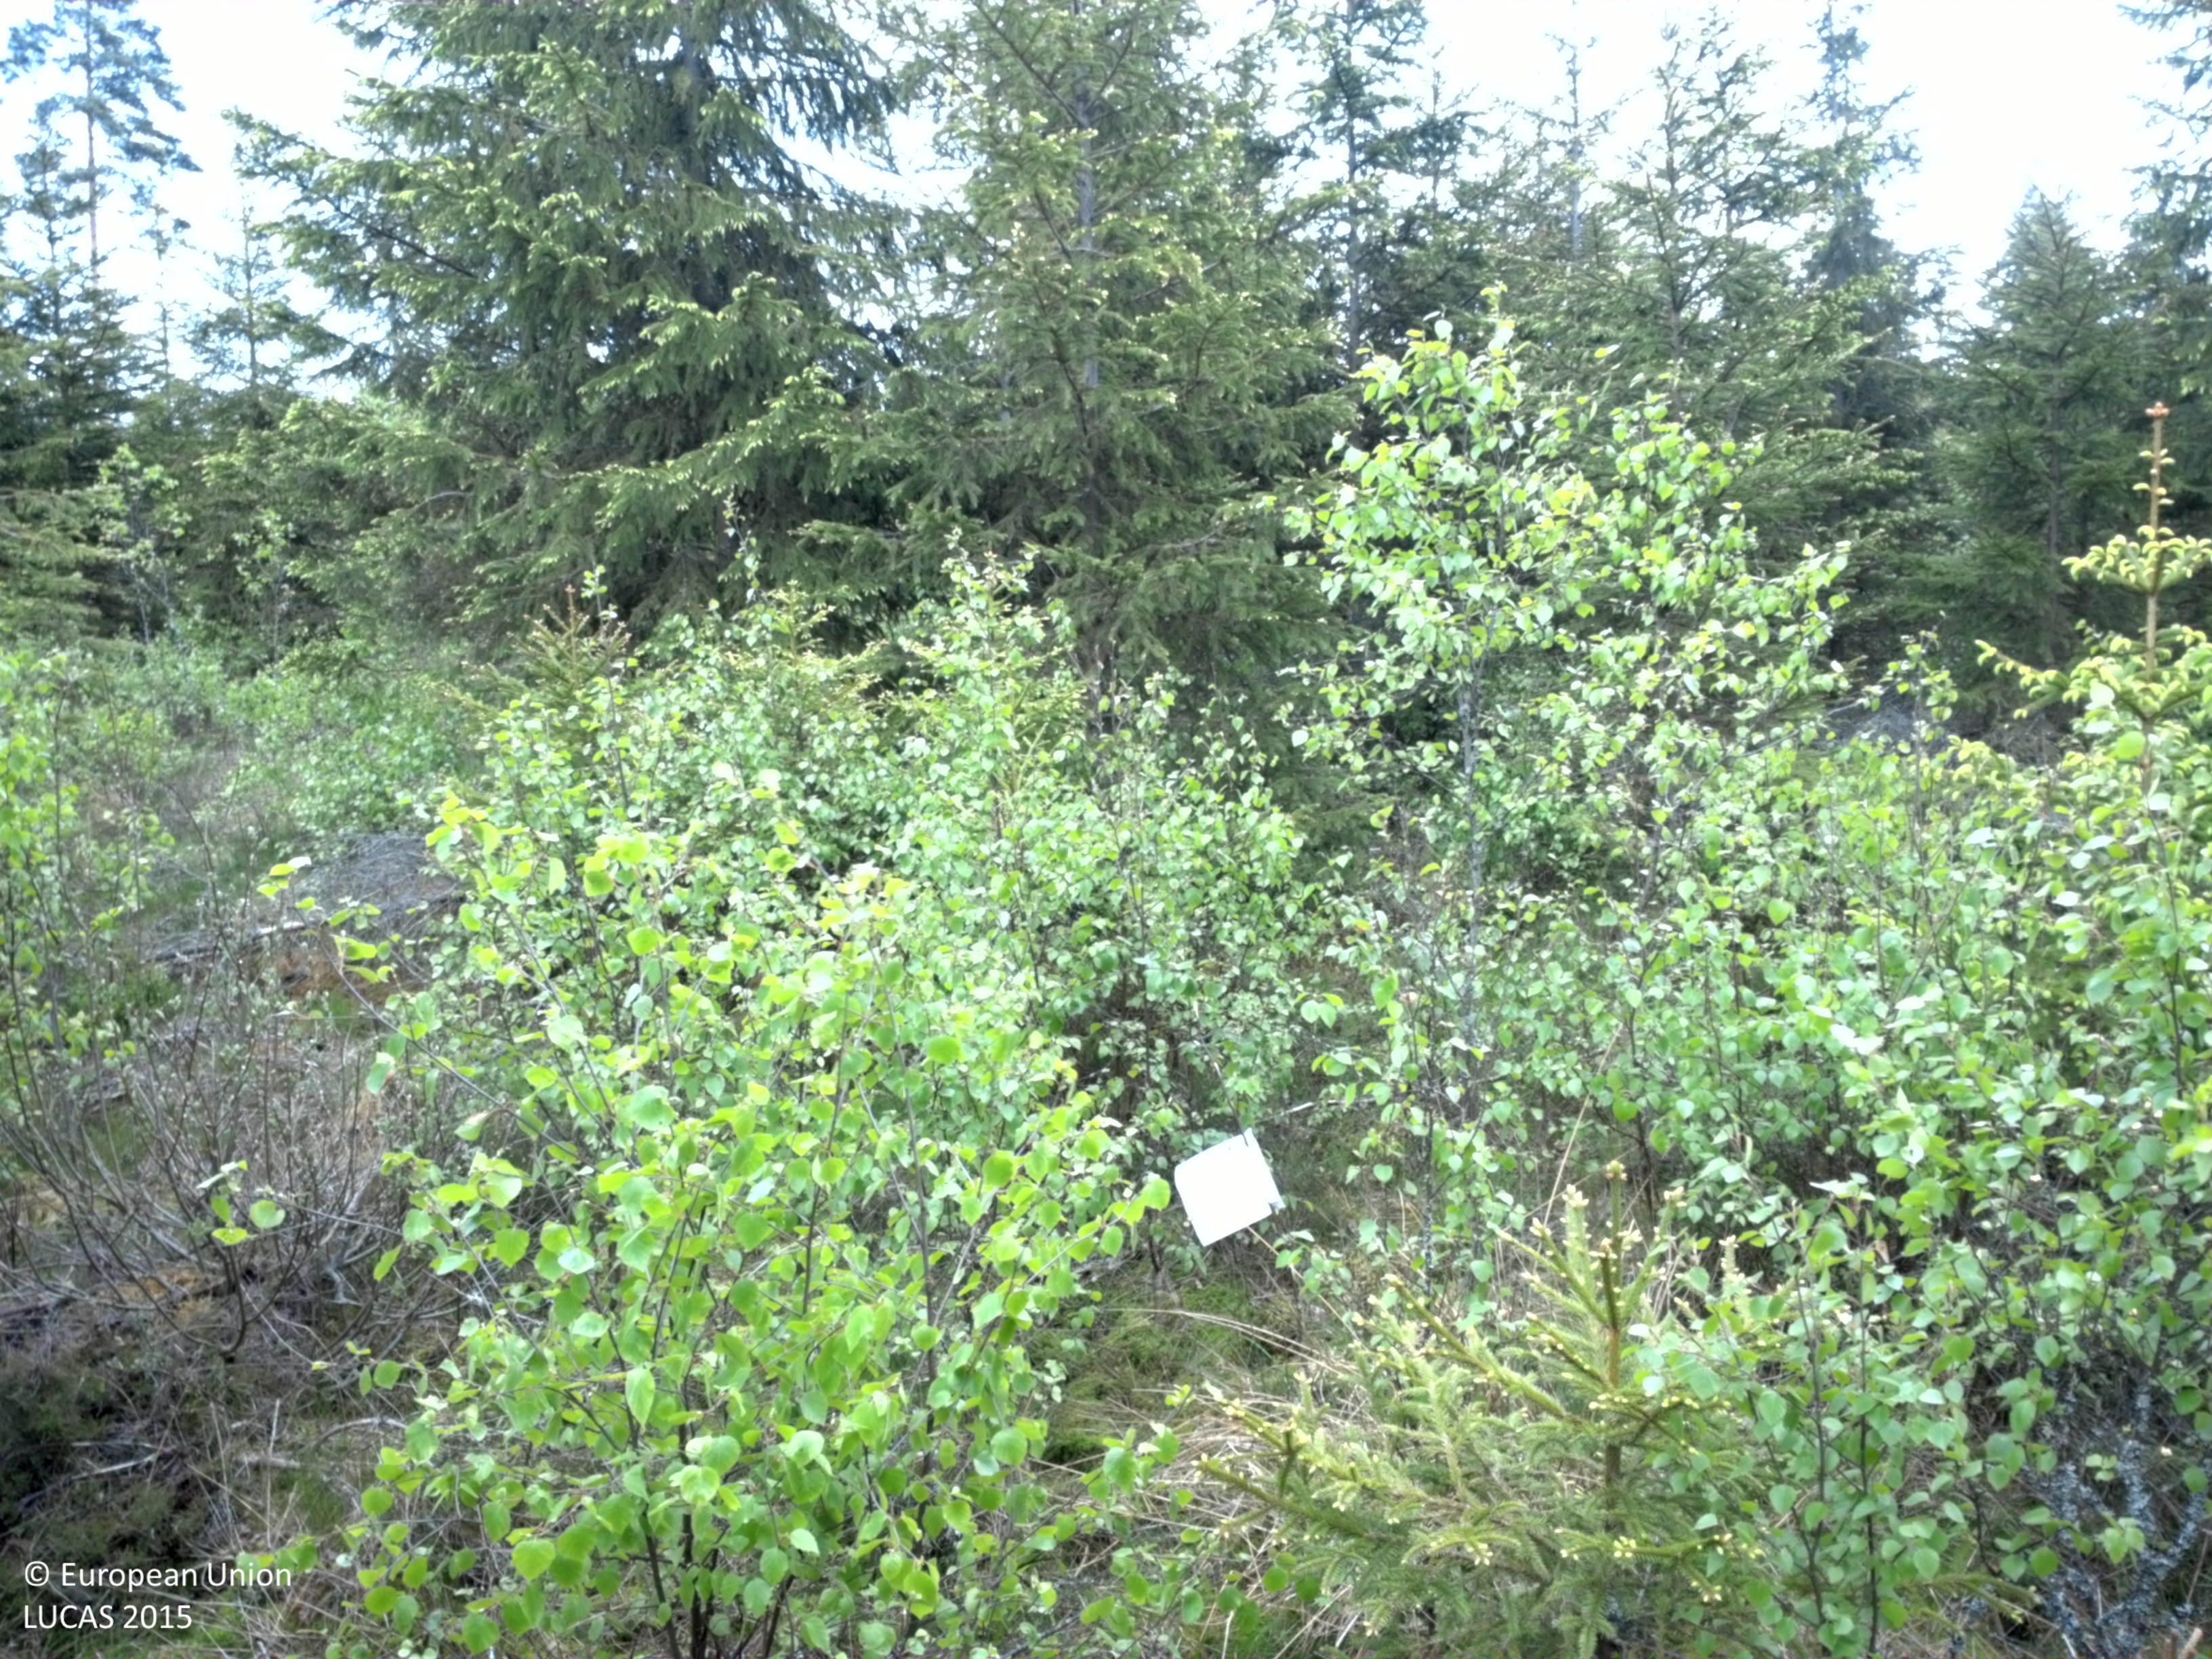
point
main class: Woodland
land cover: Spruce dominated mixed woodland
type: boreal forest
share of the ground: 50 - 75 %
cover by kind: coniferous forest trees 30 %, broadleaved forest trees 30 %, shrubs 20 %, herbaceous plants 10 %, lichens and mosses 10 %
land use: Forestry
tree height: > 5 m
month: June
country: SE
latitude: 56.8336
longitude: 14.3728
